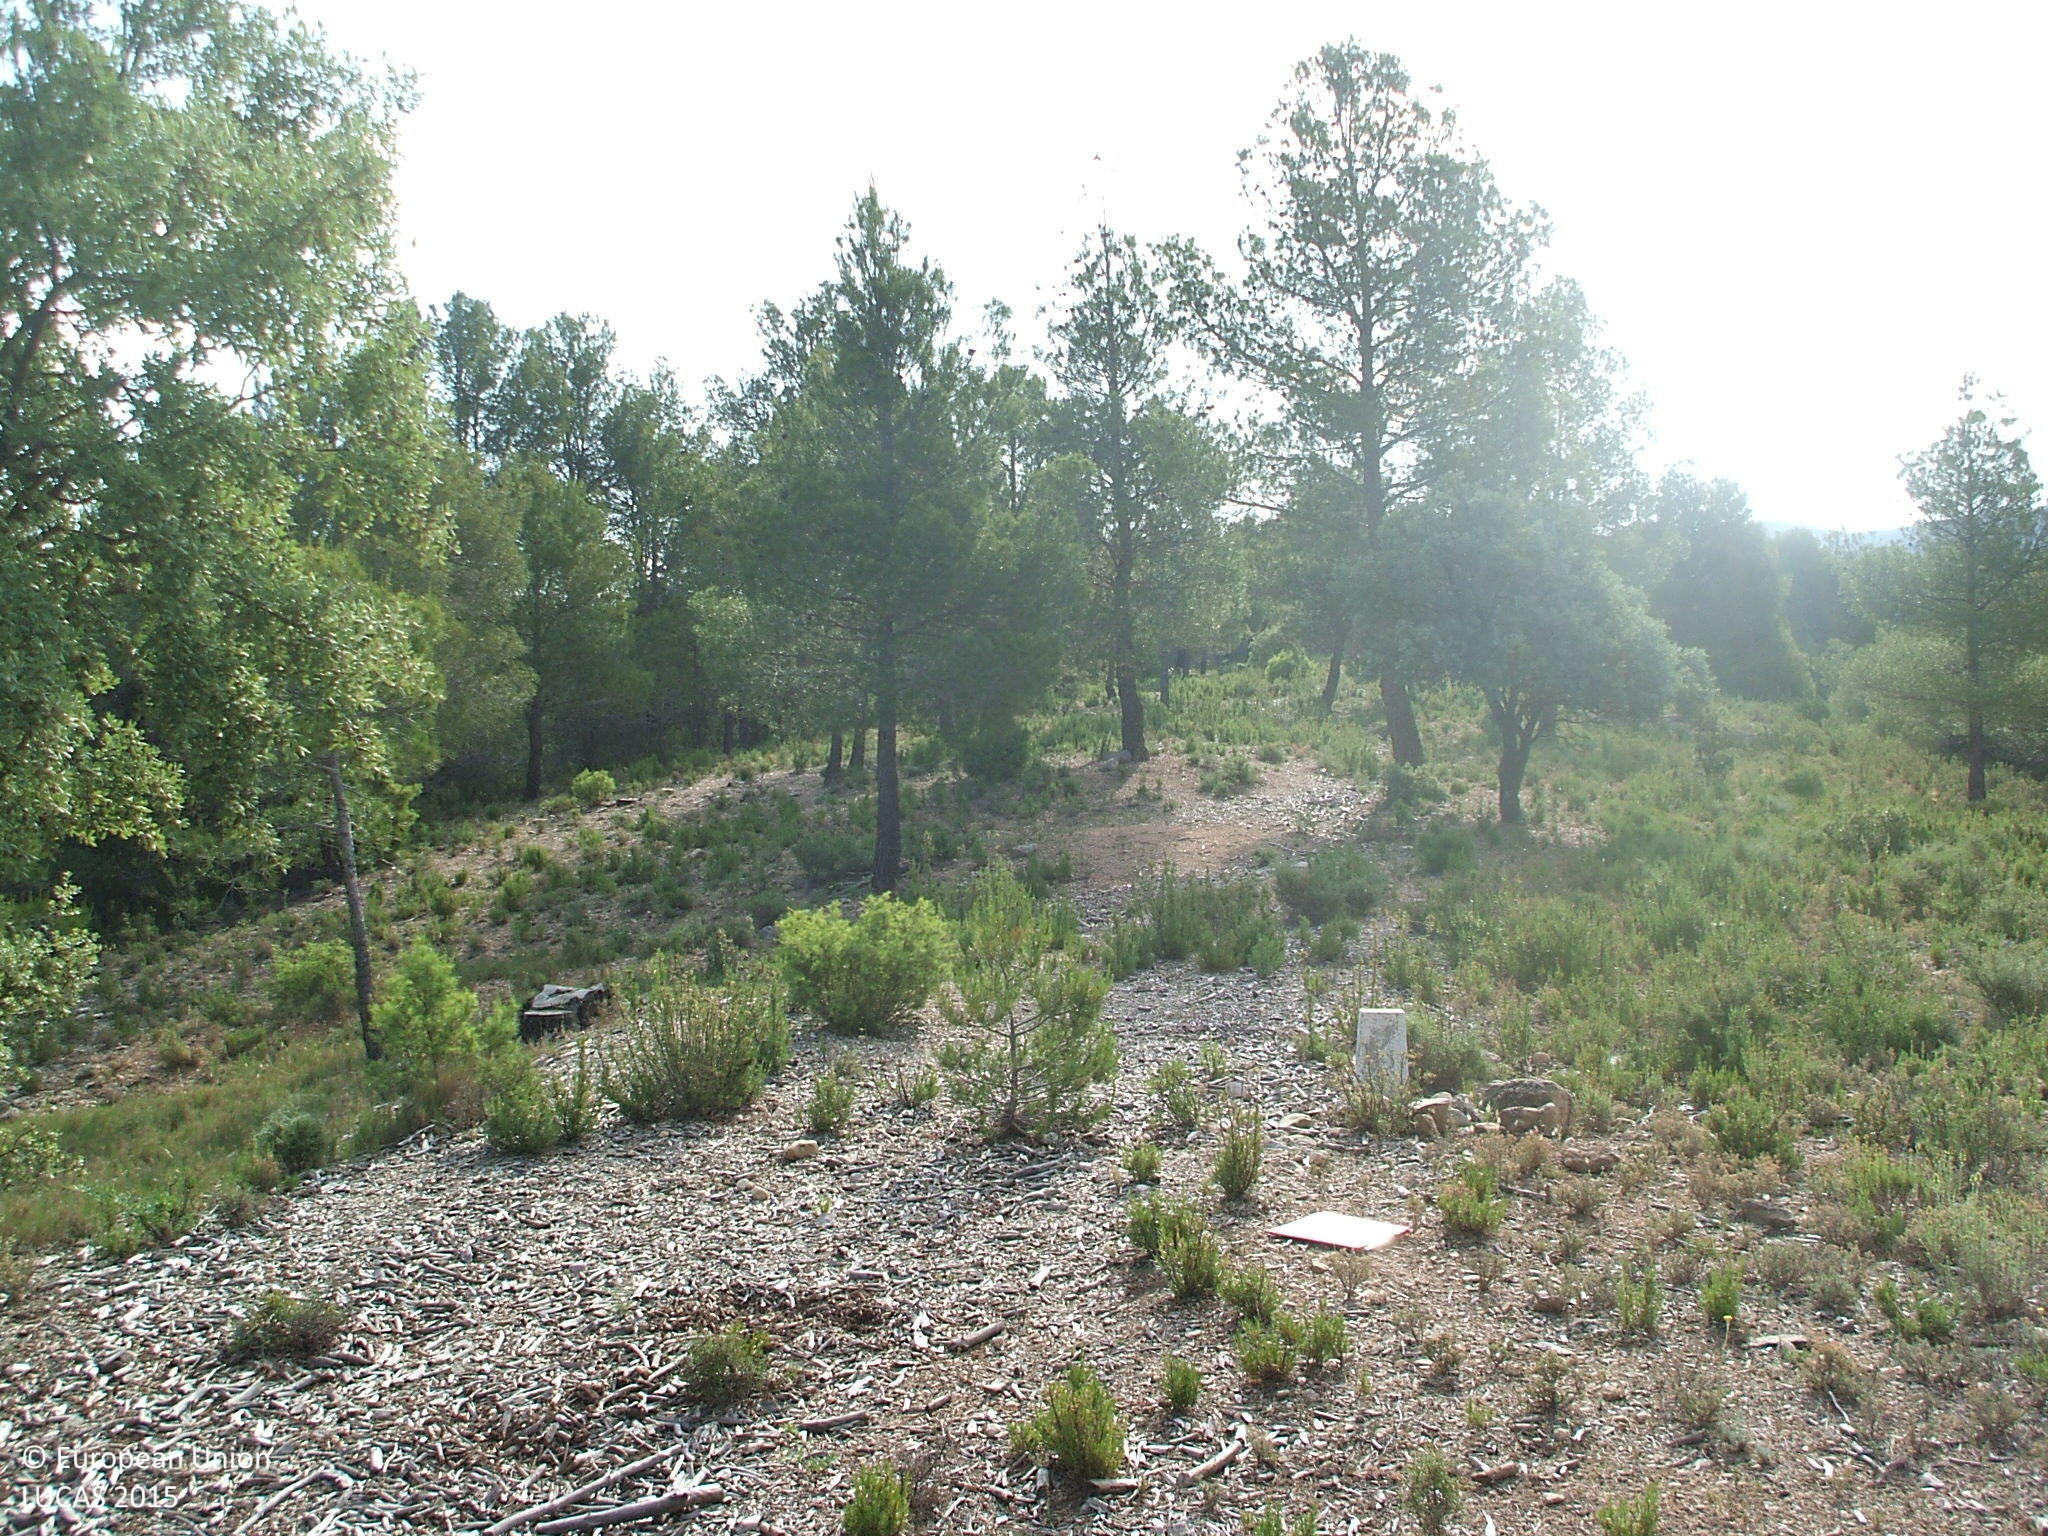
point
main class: Woodland
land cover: Pine dominated coniferous woodland
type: coniferous forest of the mediterranean region
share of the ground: 25 - 50 %
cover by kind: shrubs 40 %, coniferous forest trees 35 %, consolidated bare surface 25 %
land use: Semi-natural and natural areas not in use
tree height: > 5 m
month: June
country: ES
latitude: 40.7440
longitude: -0.3009
